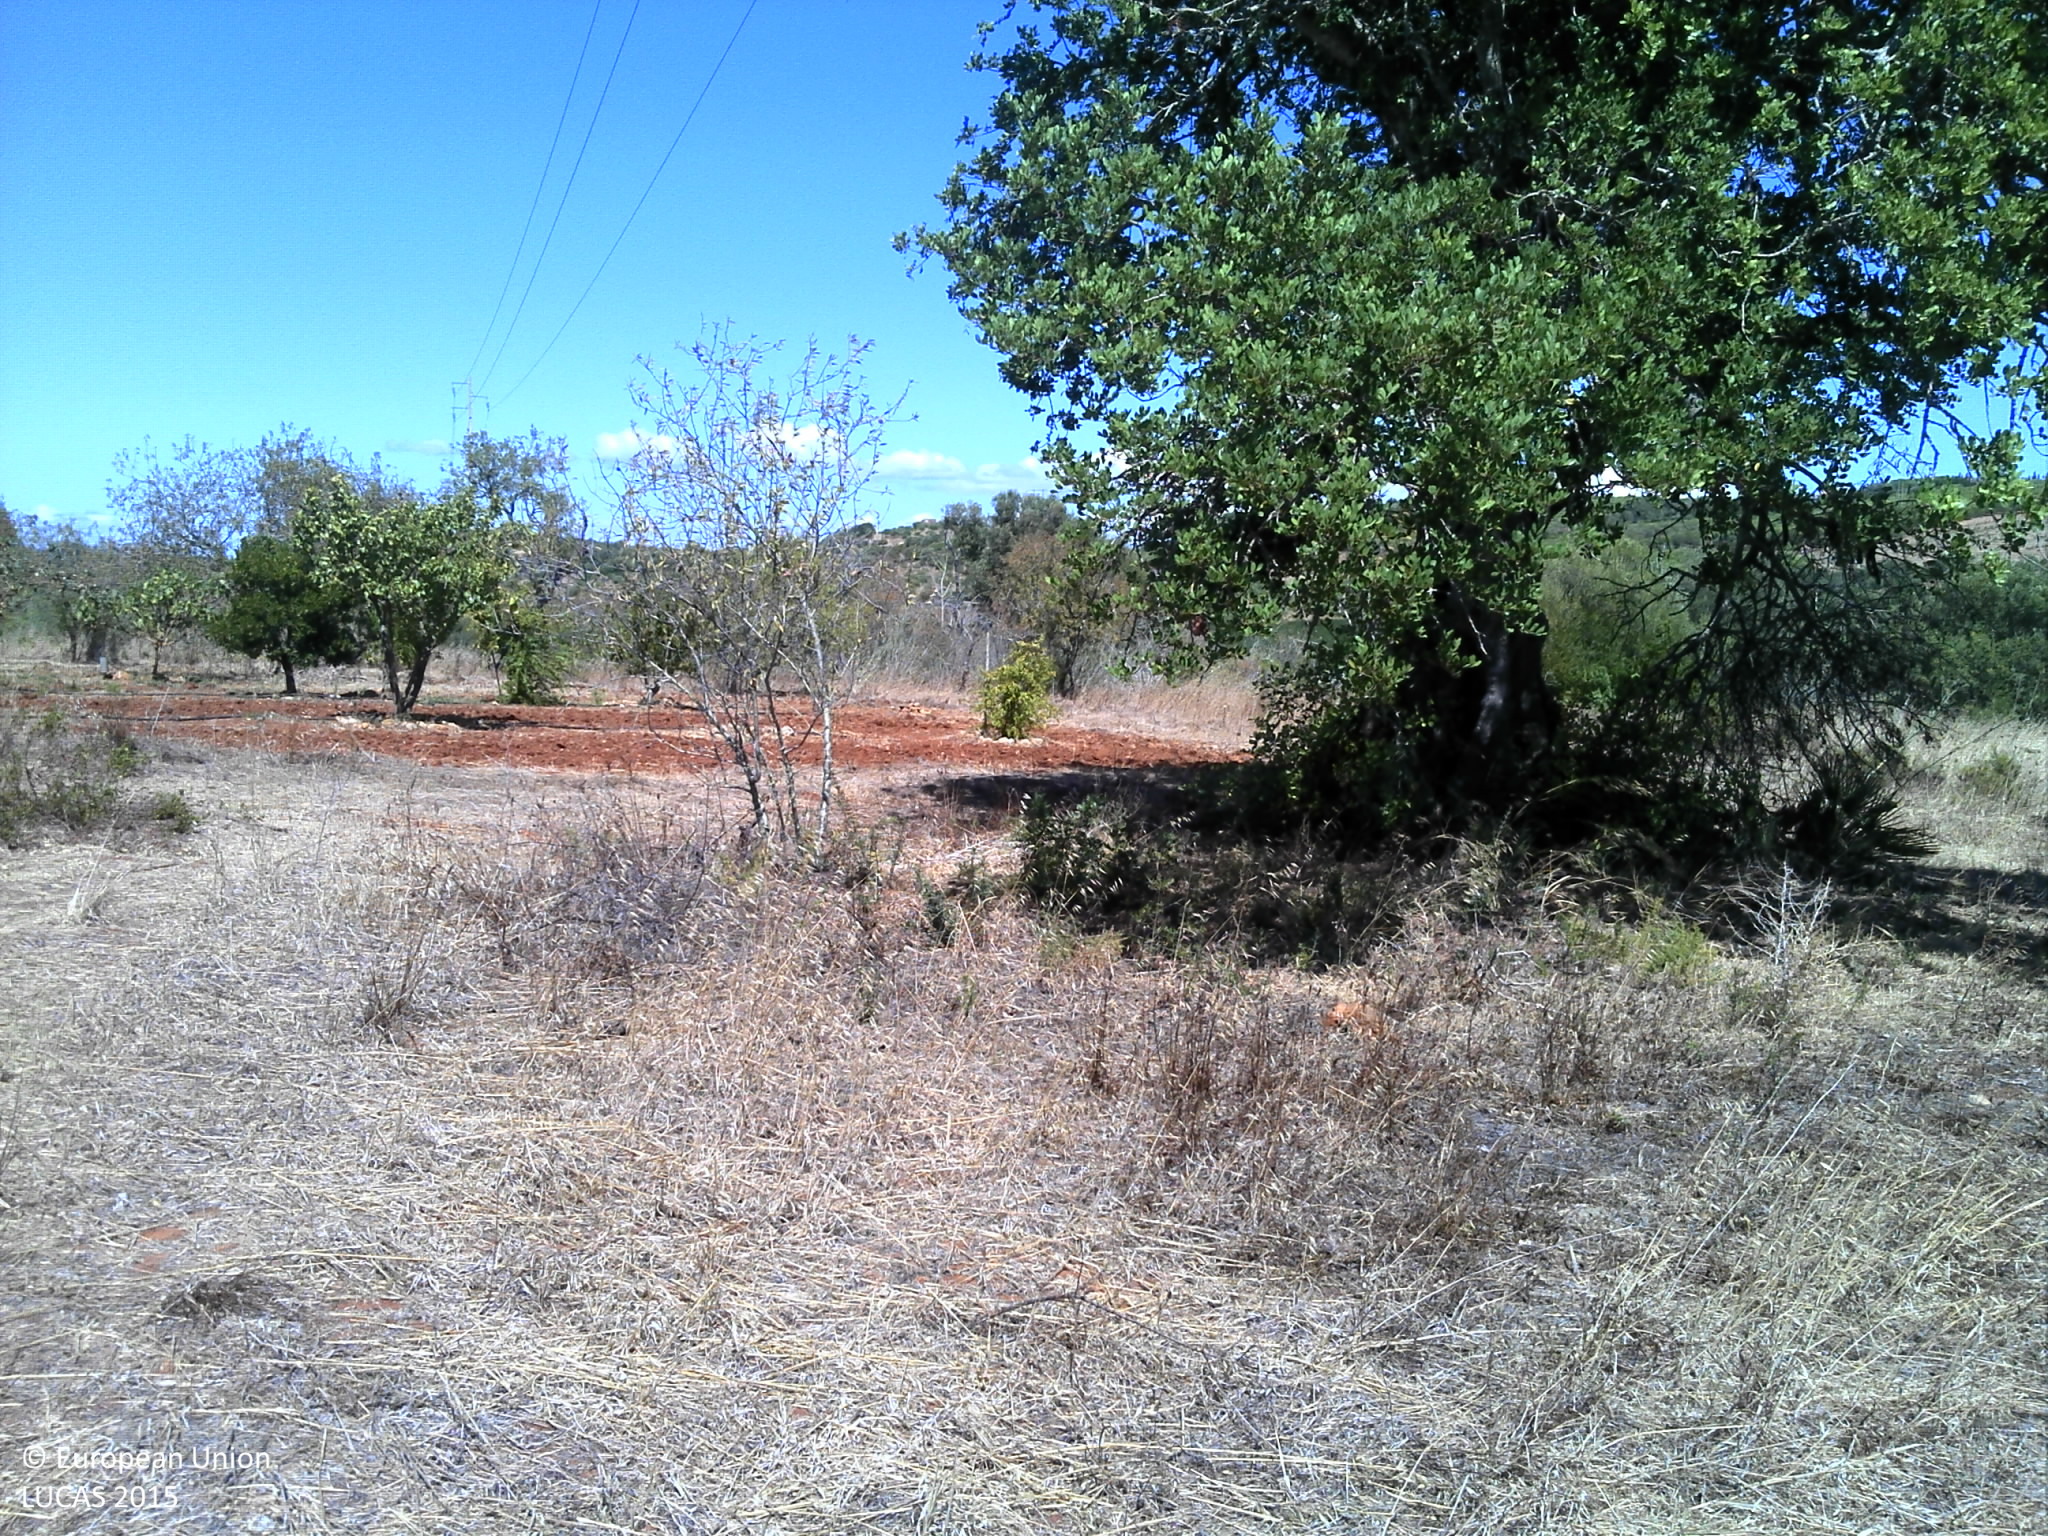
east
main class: Grassland
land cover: Grassland with sparse tree/shrub cover
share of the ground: 50 - 75 %
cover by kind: herbaceous plants 60 %, consolidated bare surface 35 %, broadleaved forest trees 5 %
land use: Agriculture (excluding fallow land and kitchen gardens)
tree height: > 5 m
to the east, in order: Grassland with sparse tree/shrub cover; Abandoned hedges; Dry stone walls; Tracks; Vineyards; Tracks; Abandoned hedges
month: July
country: PT
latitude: 37.1128
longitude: -8.7218
